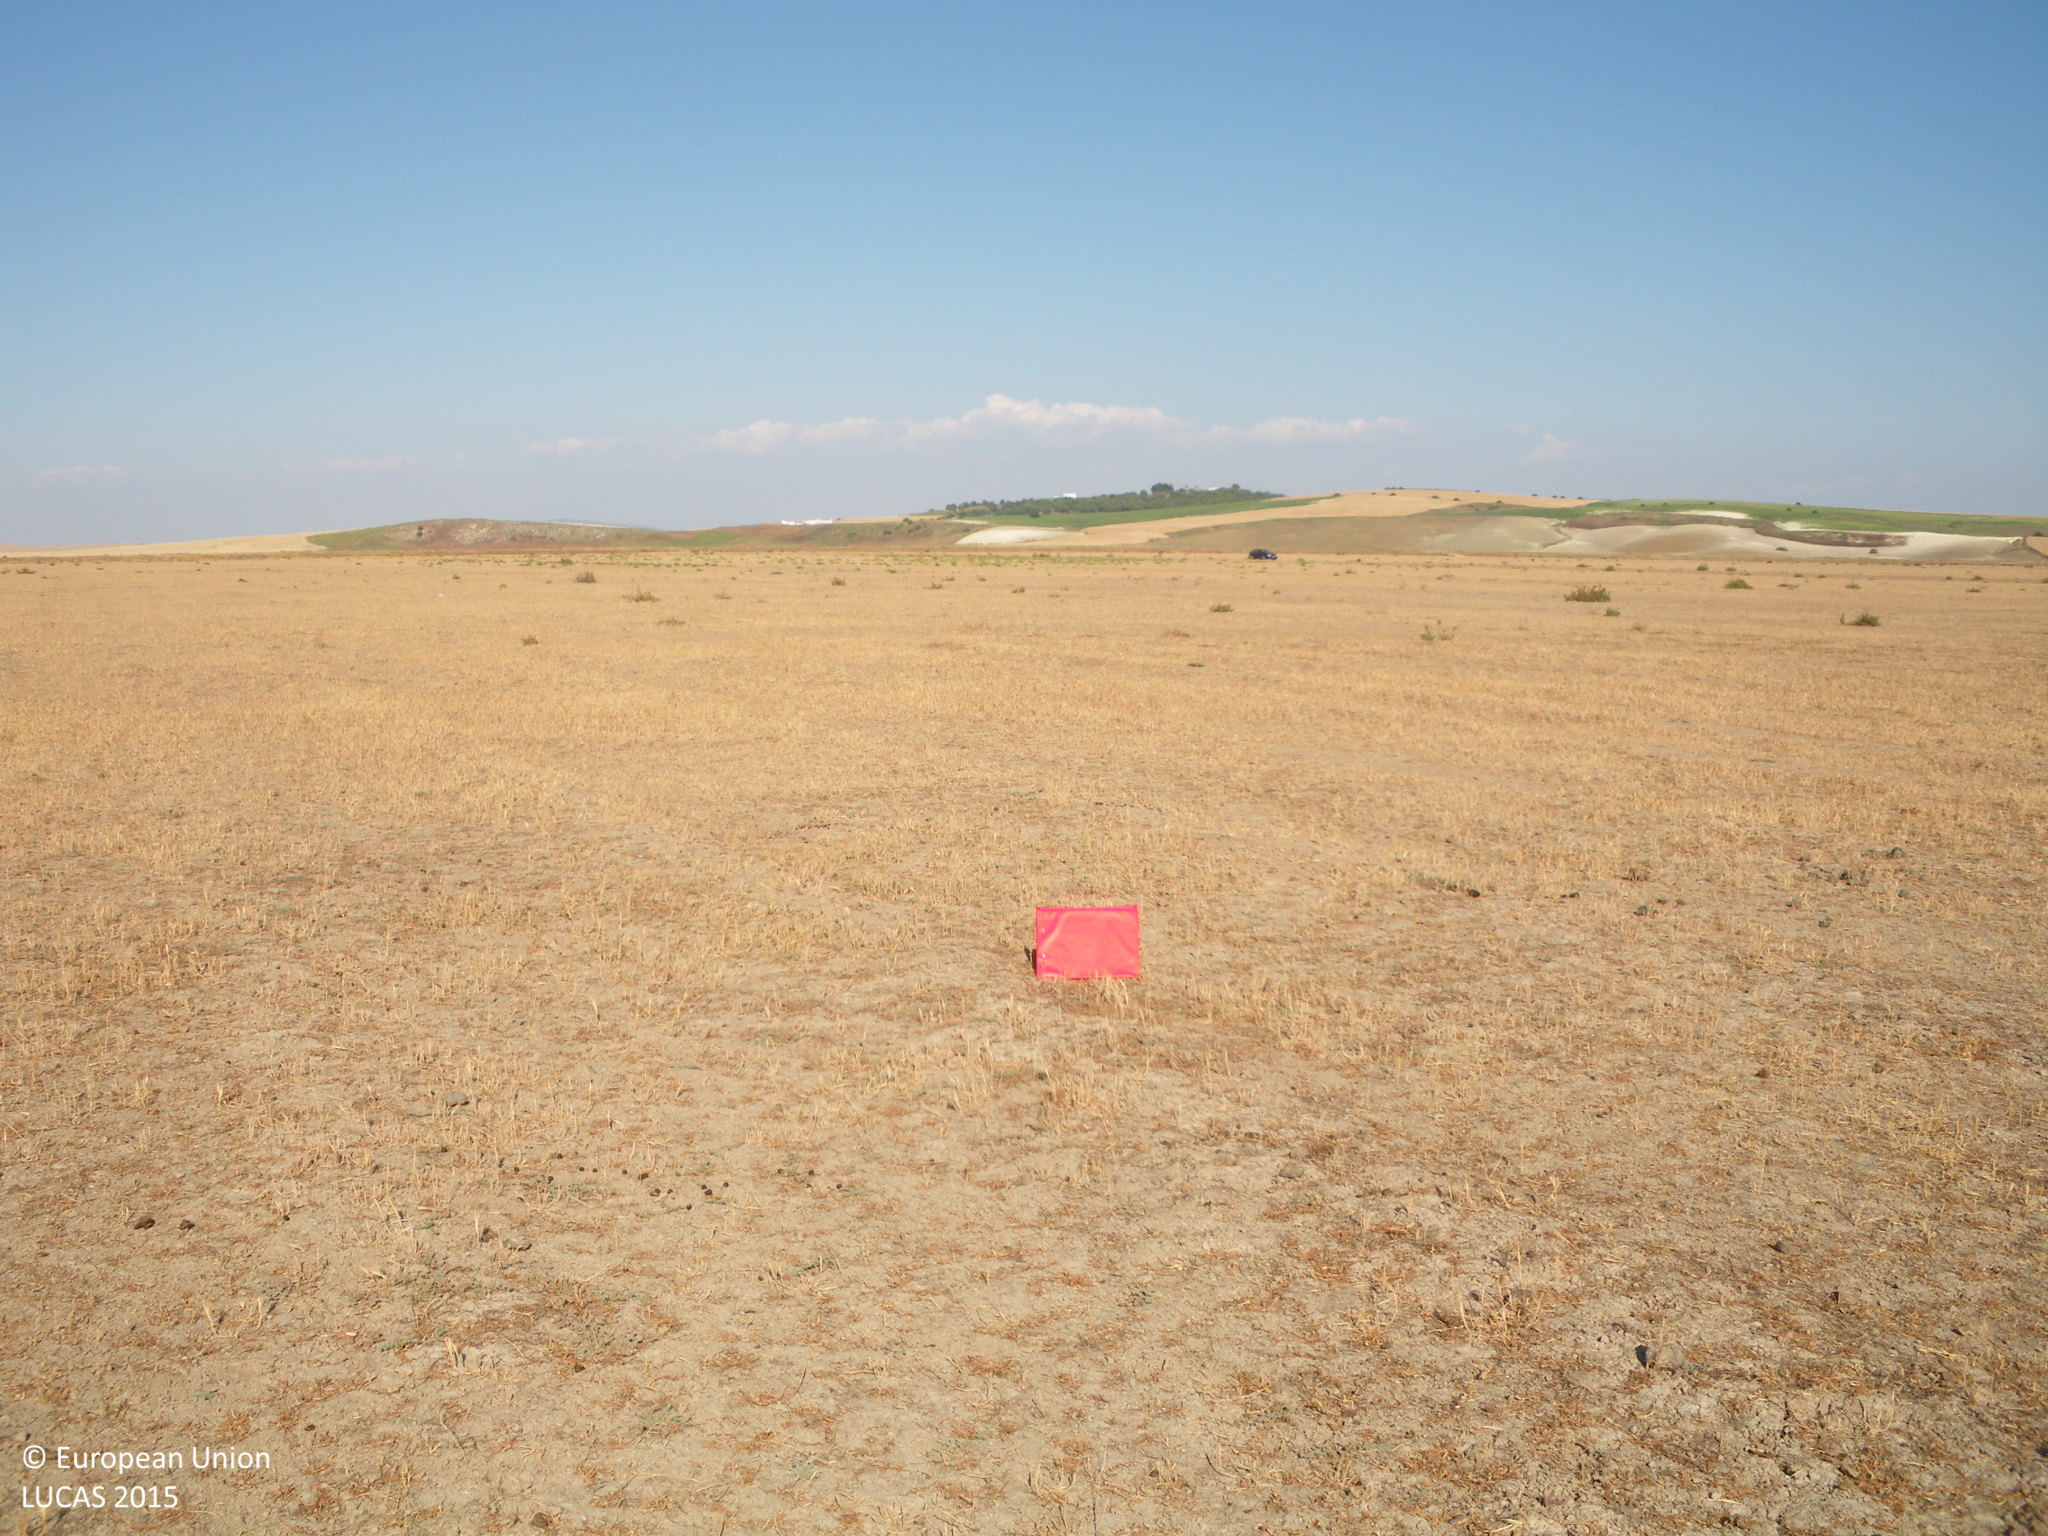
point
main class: Grassland
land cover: Spontaneously vegetated surfaces
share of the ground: > 75 %
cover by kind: herbaceous plants 80 %, unconsolidated bare surface 20 %
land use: Agriculture (excluding fallow land and kitchen gardens)
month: May
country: ES
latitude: 36.8353
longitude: -6.2648
